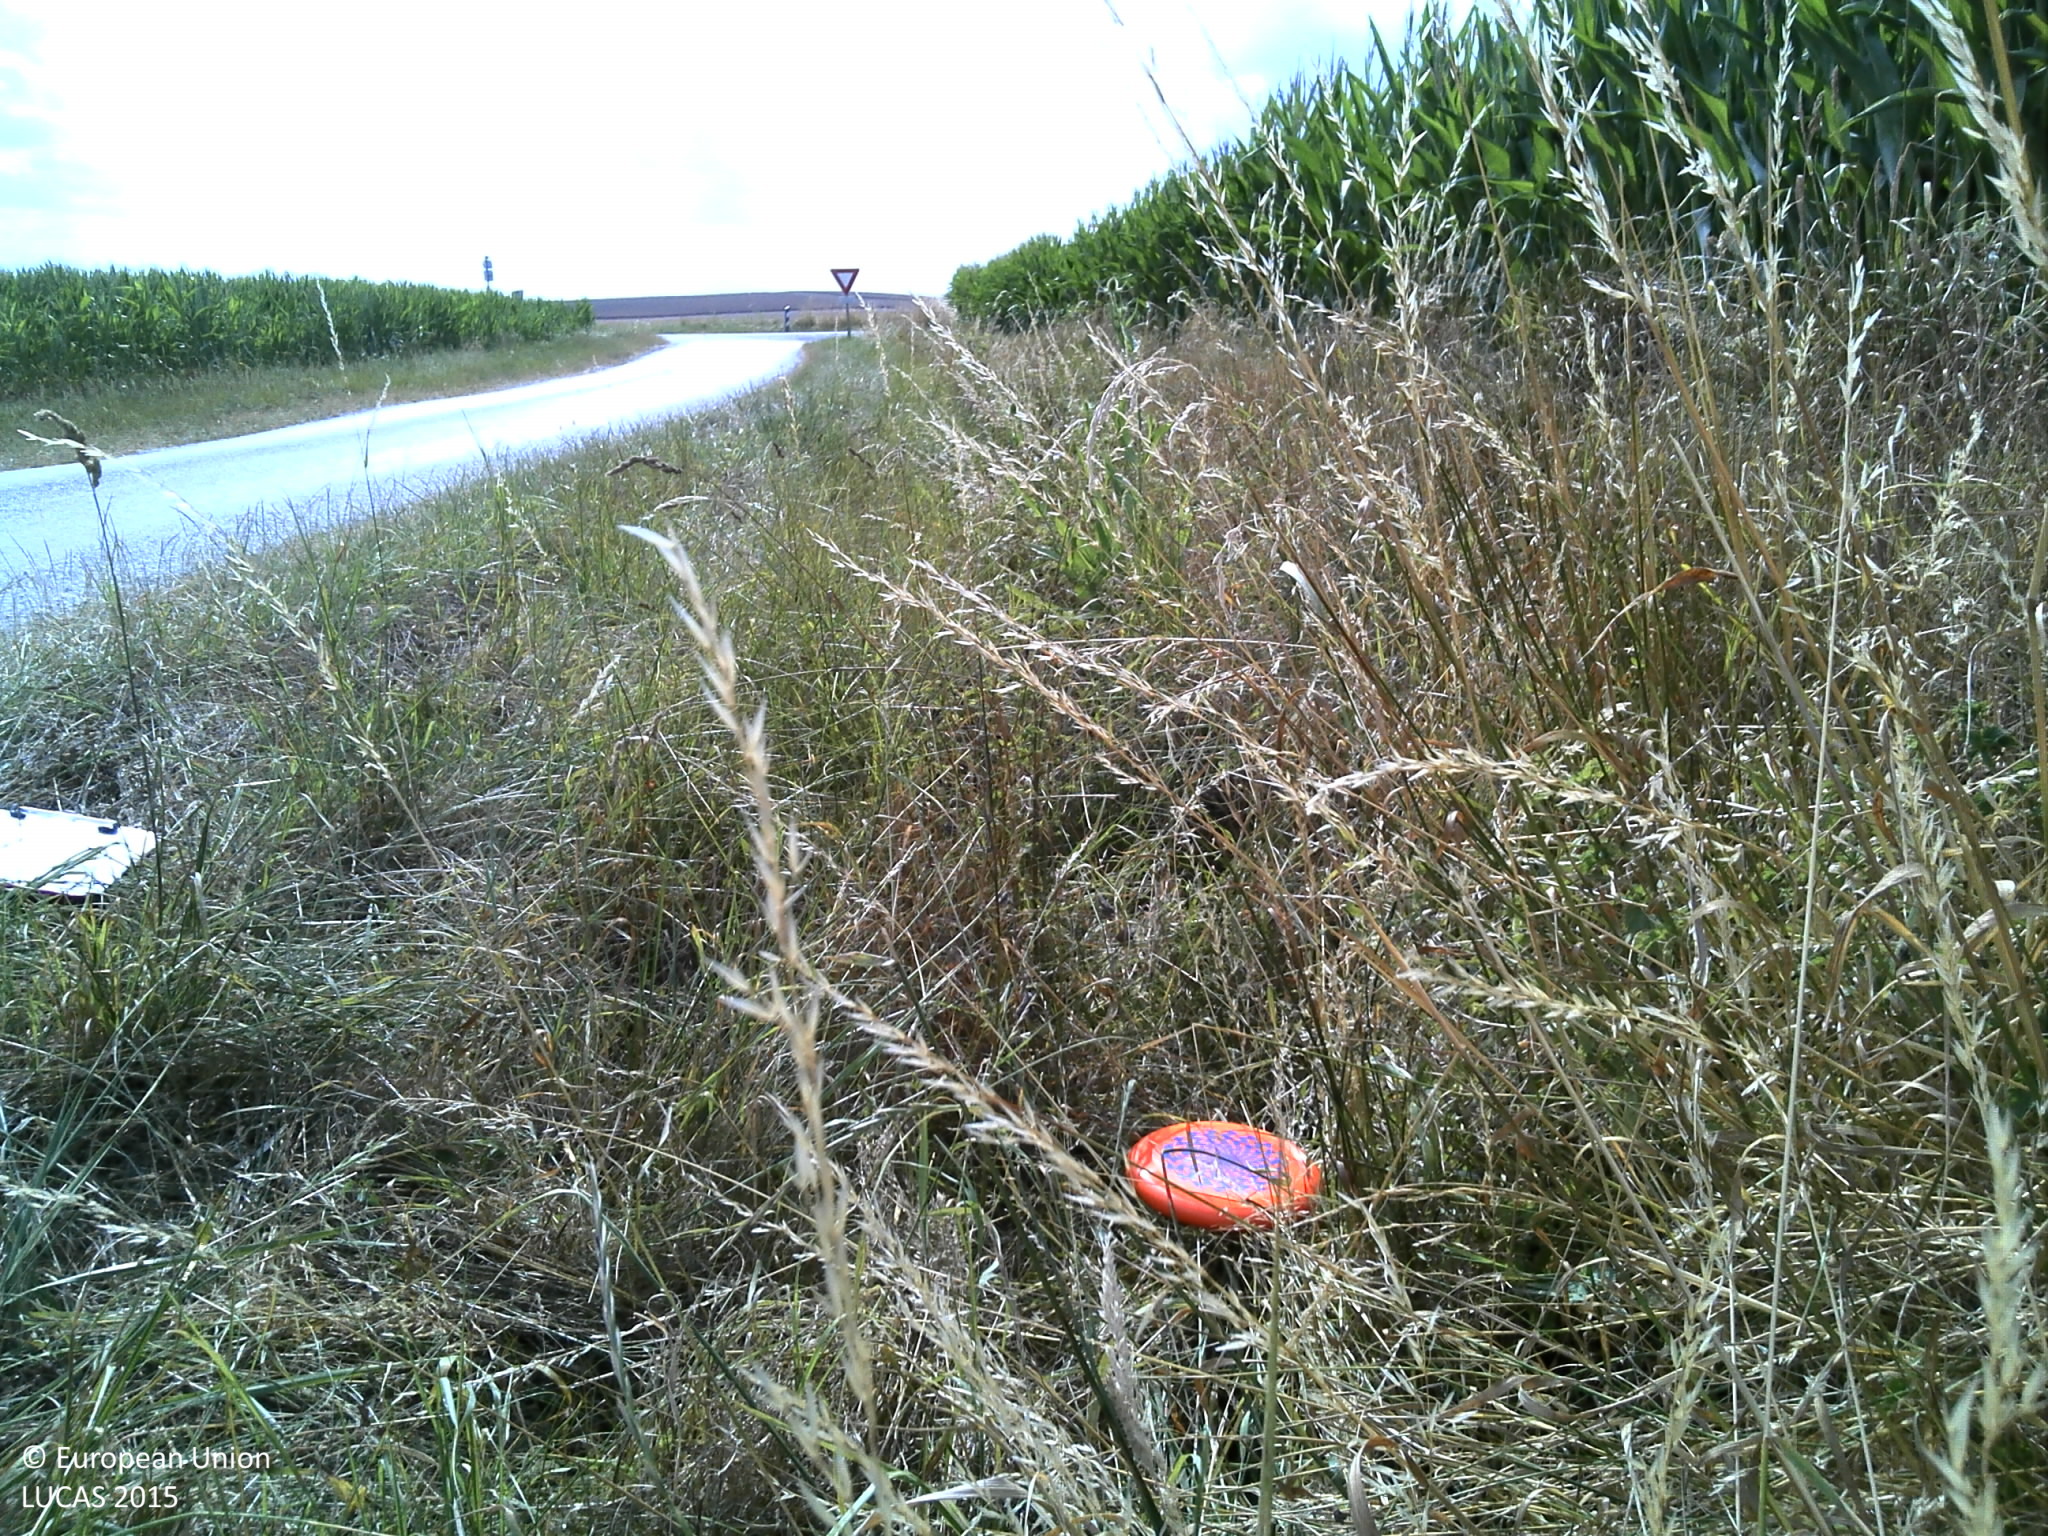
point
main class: Cropland
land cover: Rape and turnip rape
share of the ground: > 75 %
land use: Agriculture (excluding fallow land and kitchen gardens)
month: July
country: FR
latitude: 49.0415
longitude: 4.8675
